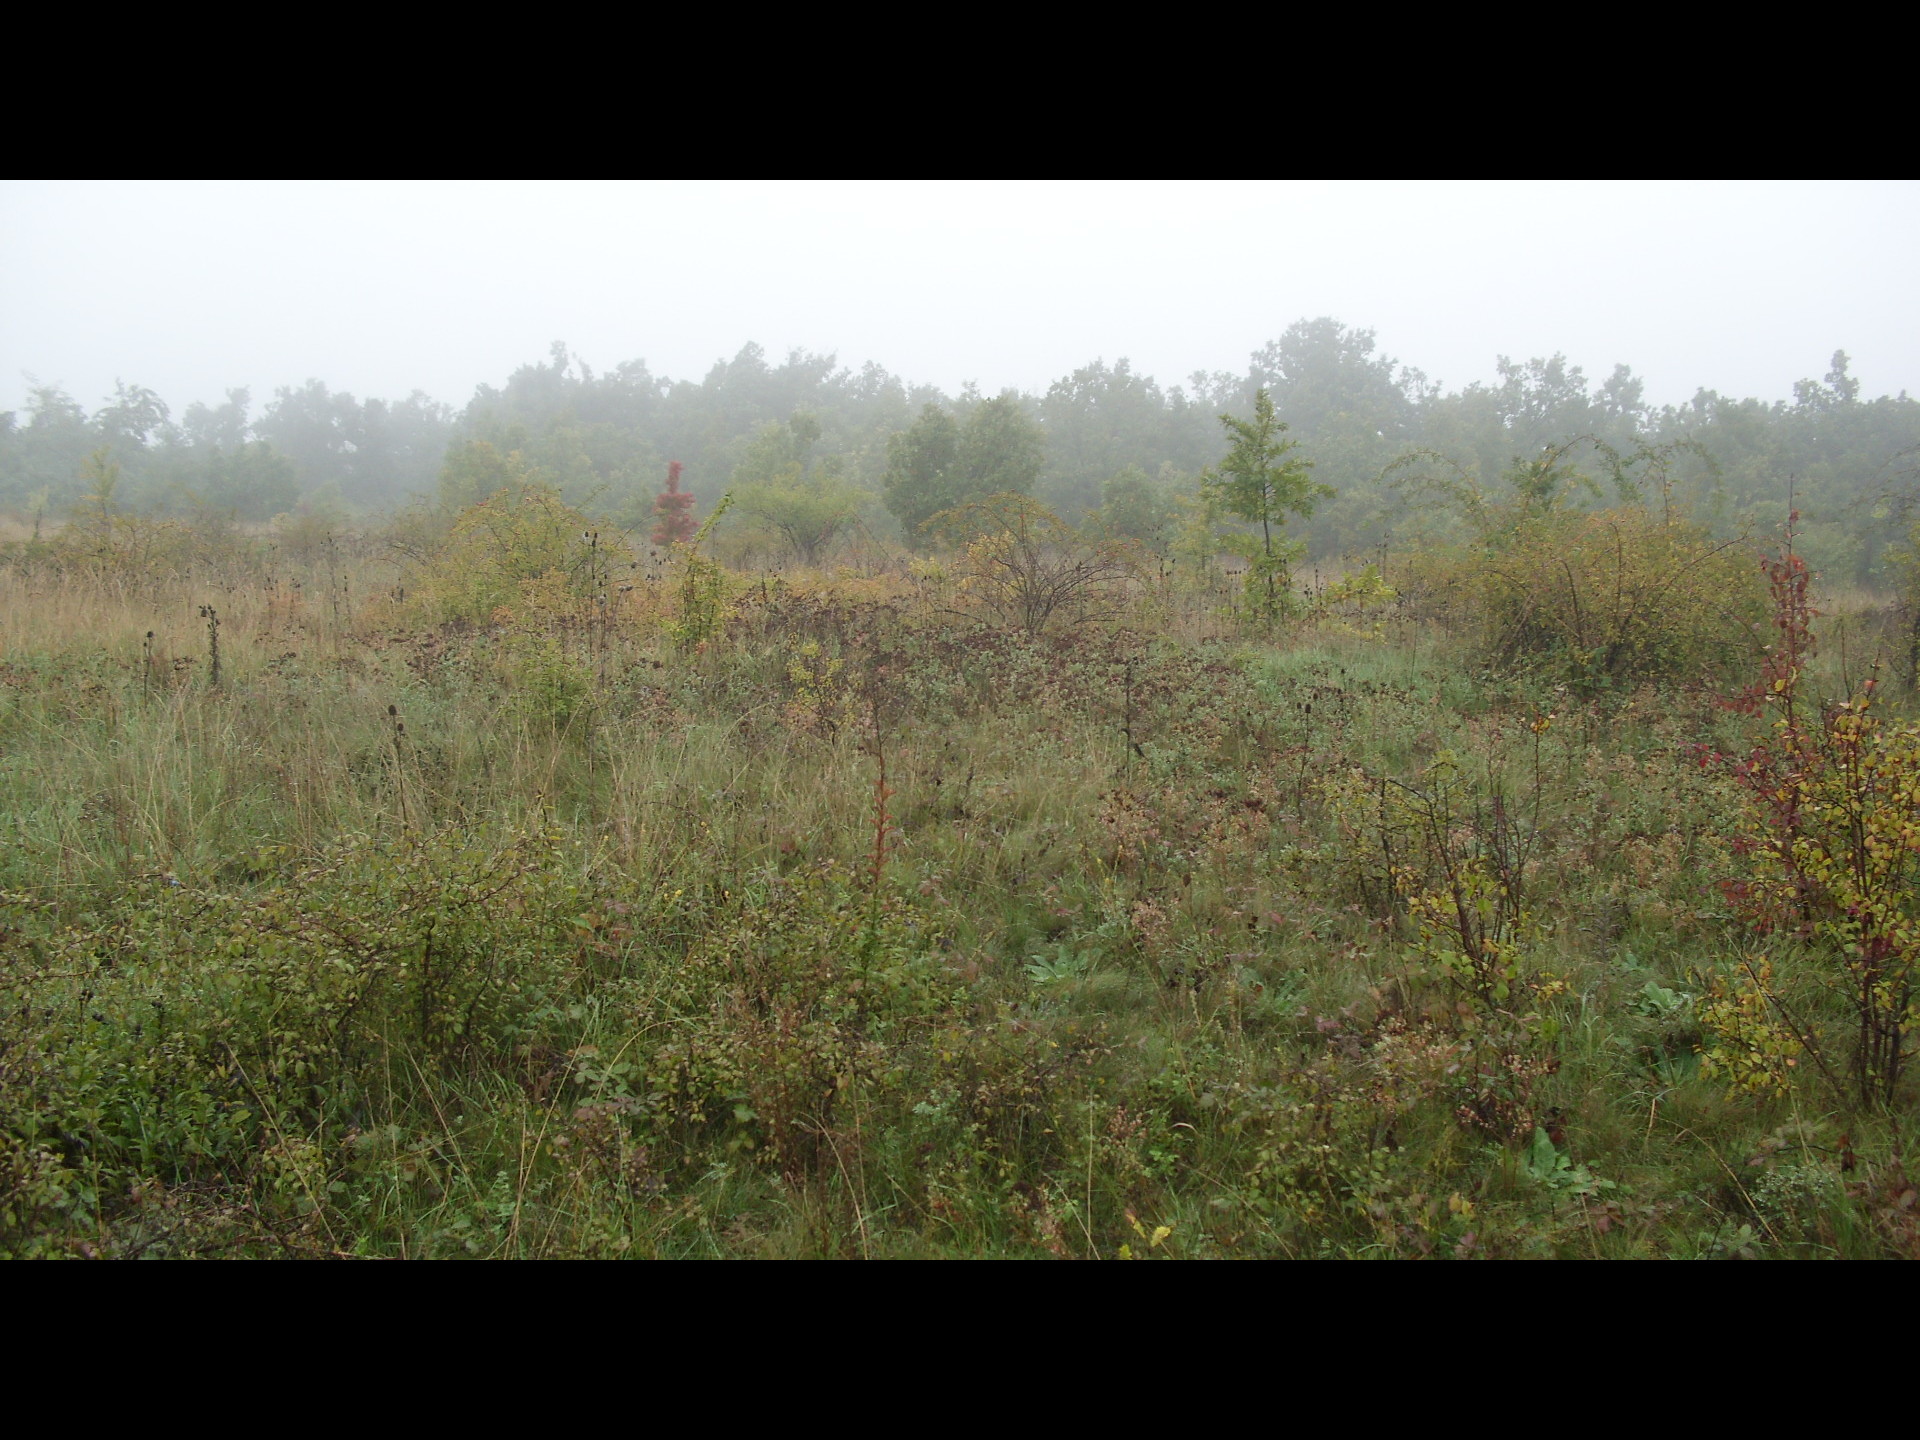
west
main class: Grassland
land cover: Grassland with sparse tree/shrub cover
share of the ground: > 75 %
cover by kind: herbaceous plants 85 %, shrubs 10 %, broadleaved forest trees 5 %
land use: Semi-natural and natural areas not in use
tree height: < 5 m
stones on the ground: < 10 %
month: October
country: BG
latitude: 43.7923
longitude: 22.4976
